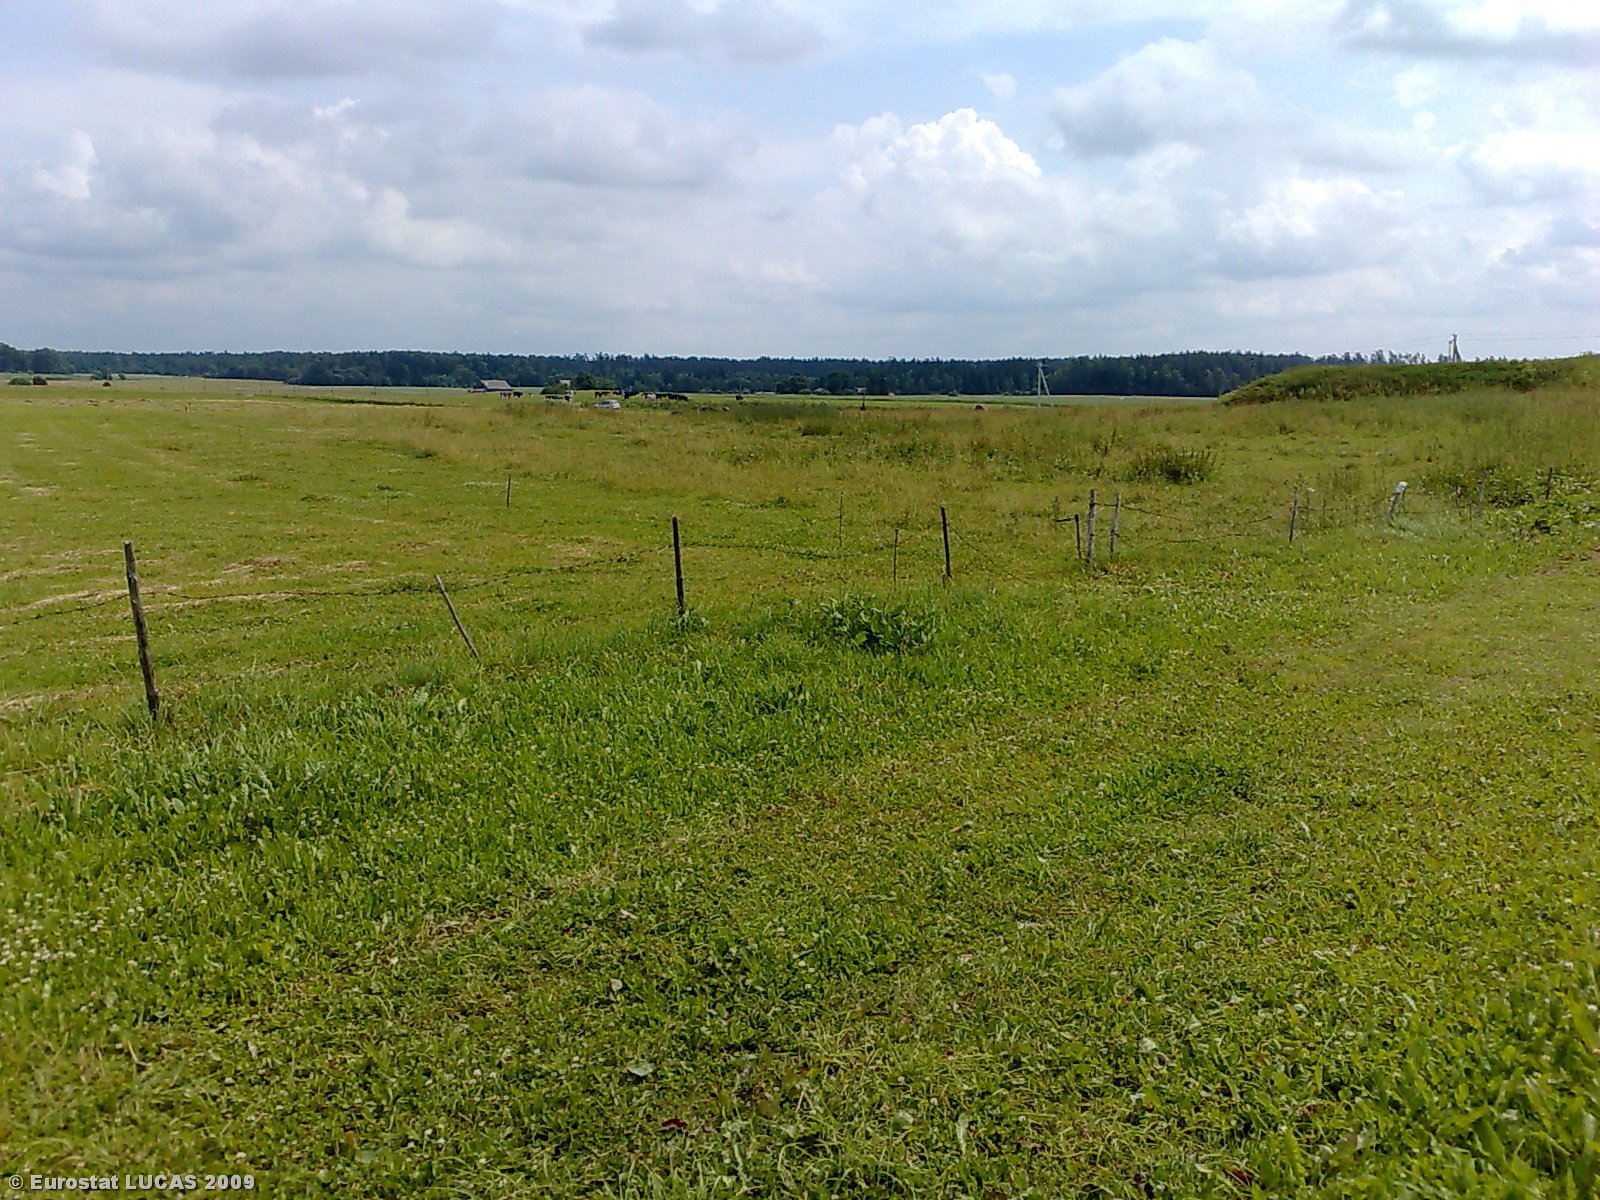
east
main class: Grassland
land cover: Grassland without tree/shrub cover
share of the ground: > 75 %
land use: Agriculture (excluding fallow land and kitchen gardens)
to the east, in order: Grassland without tree/shrub cover; Fences; Paved roads, cycling and walking lanes; Grassland without tree/shrub cover; Single bushes/trees; Ditches and canals; Grassland without tree/shrub cover
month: July
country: LT
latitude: 55.5826
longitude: 22.7724
